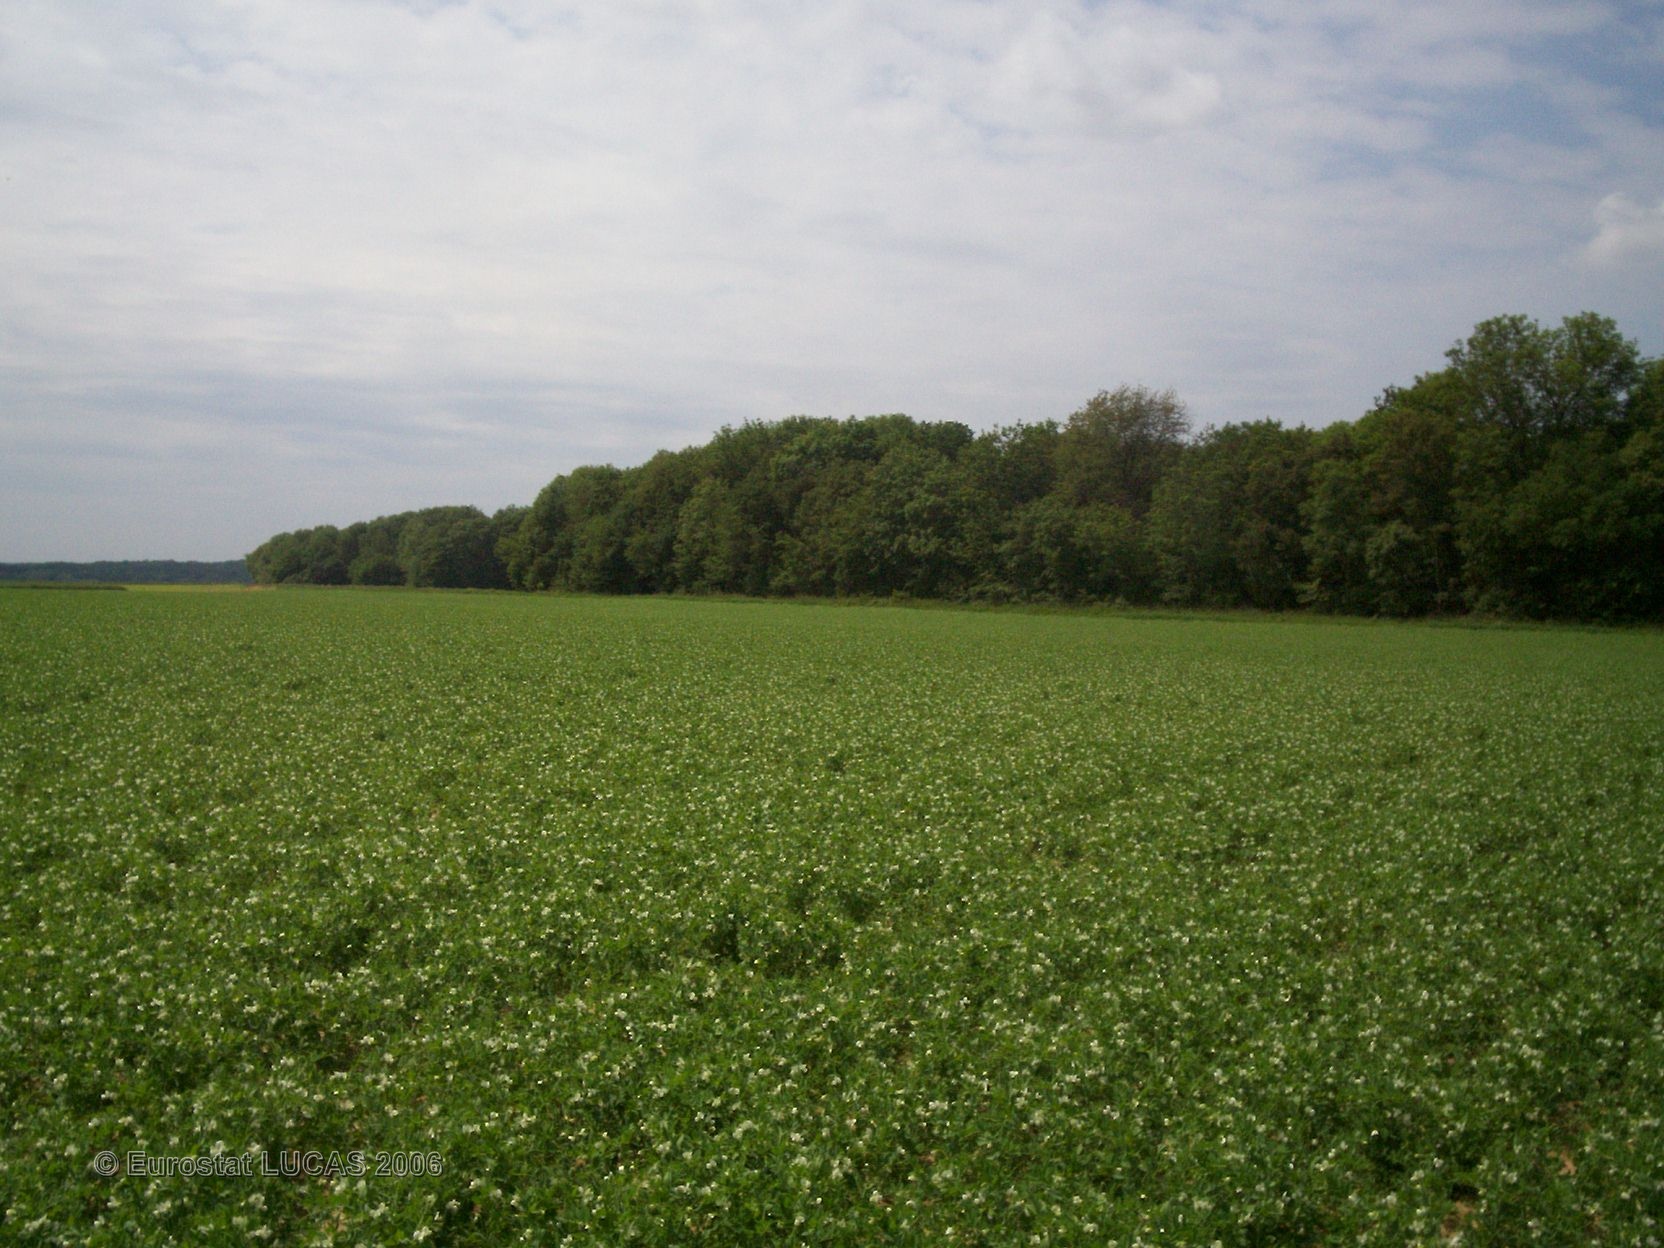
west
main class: Cropland
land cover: Dry pulses
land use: Agriculture (excluding fallow land and kitchen gardens)
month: June
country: FR
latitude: 49.7105
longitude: 2.6247
